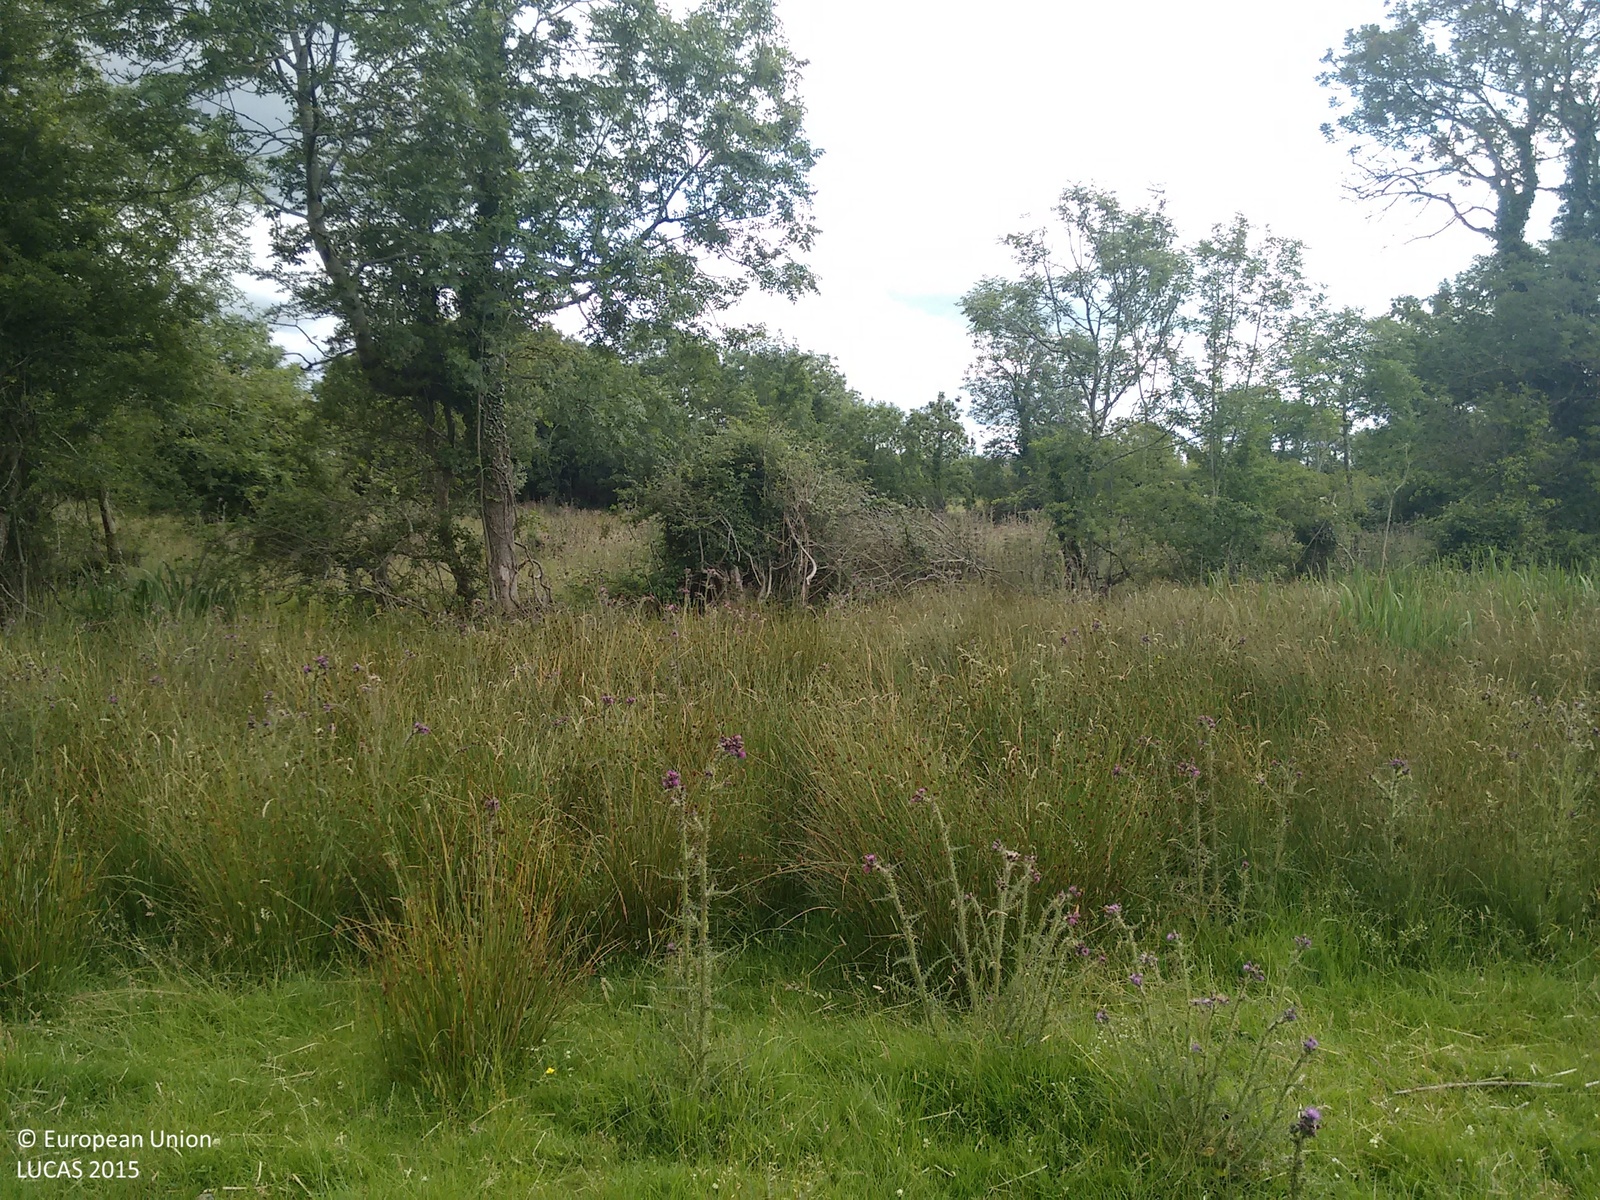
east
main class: Grassland
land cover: Grassland without tree/shrub cover
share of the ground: > 75 %
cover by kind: herbaceous plants 95 %, shrubs 5 %
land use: Agriculture (excluding fallow land and kitchen gardens)
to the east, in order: Grassland without tree/shrub cover; Abandoned hedges; Grassland without tree/shrub cover; Broadleaved woodland; Rivers and streams; Fences; Grassland without tree/shrub cover; Fences; Managed hedges; Grassland without tree/shrub cover
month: July
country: IE
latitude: 53.5544
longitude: -7.8456
